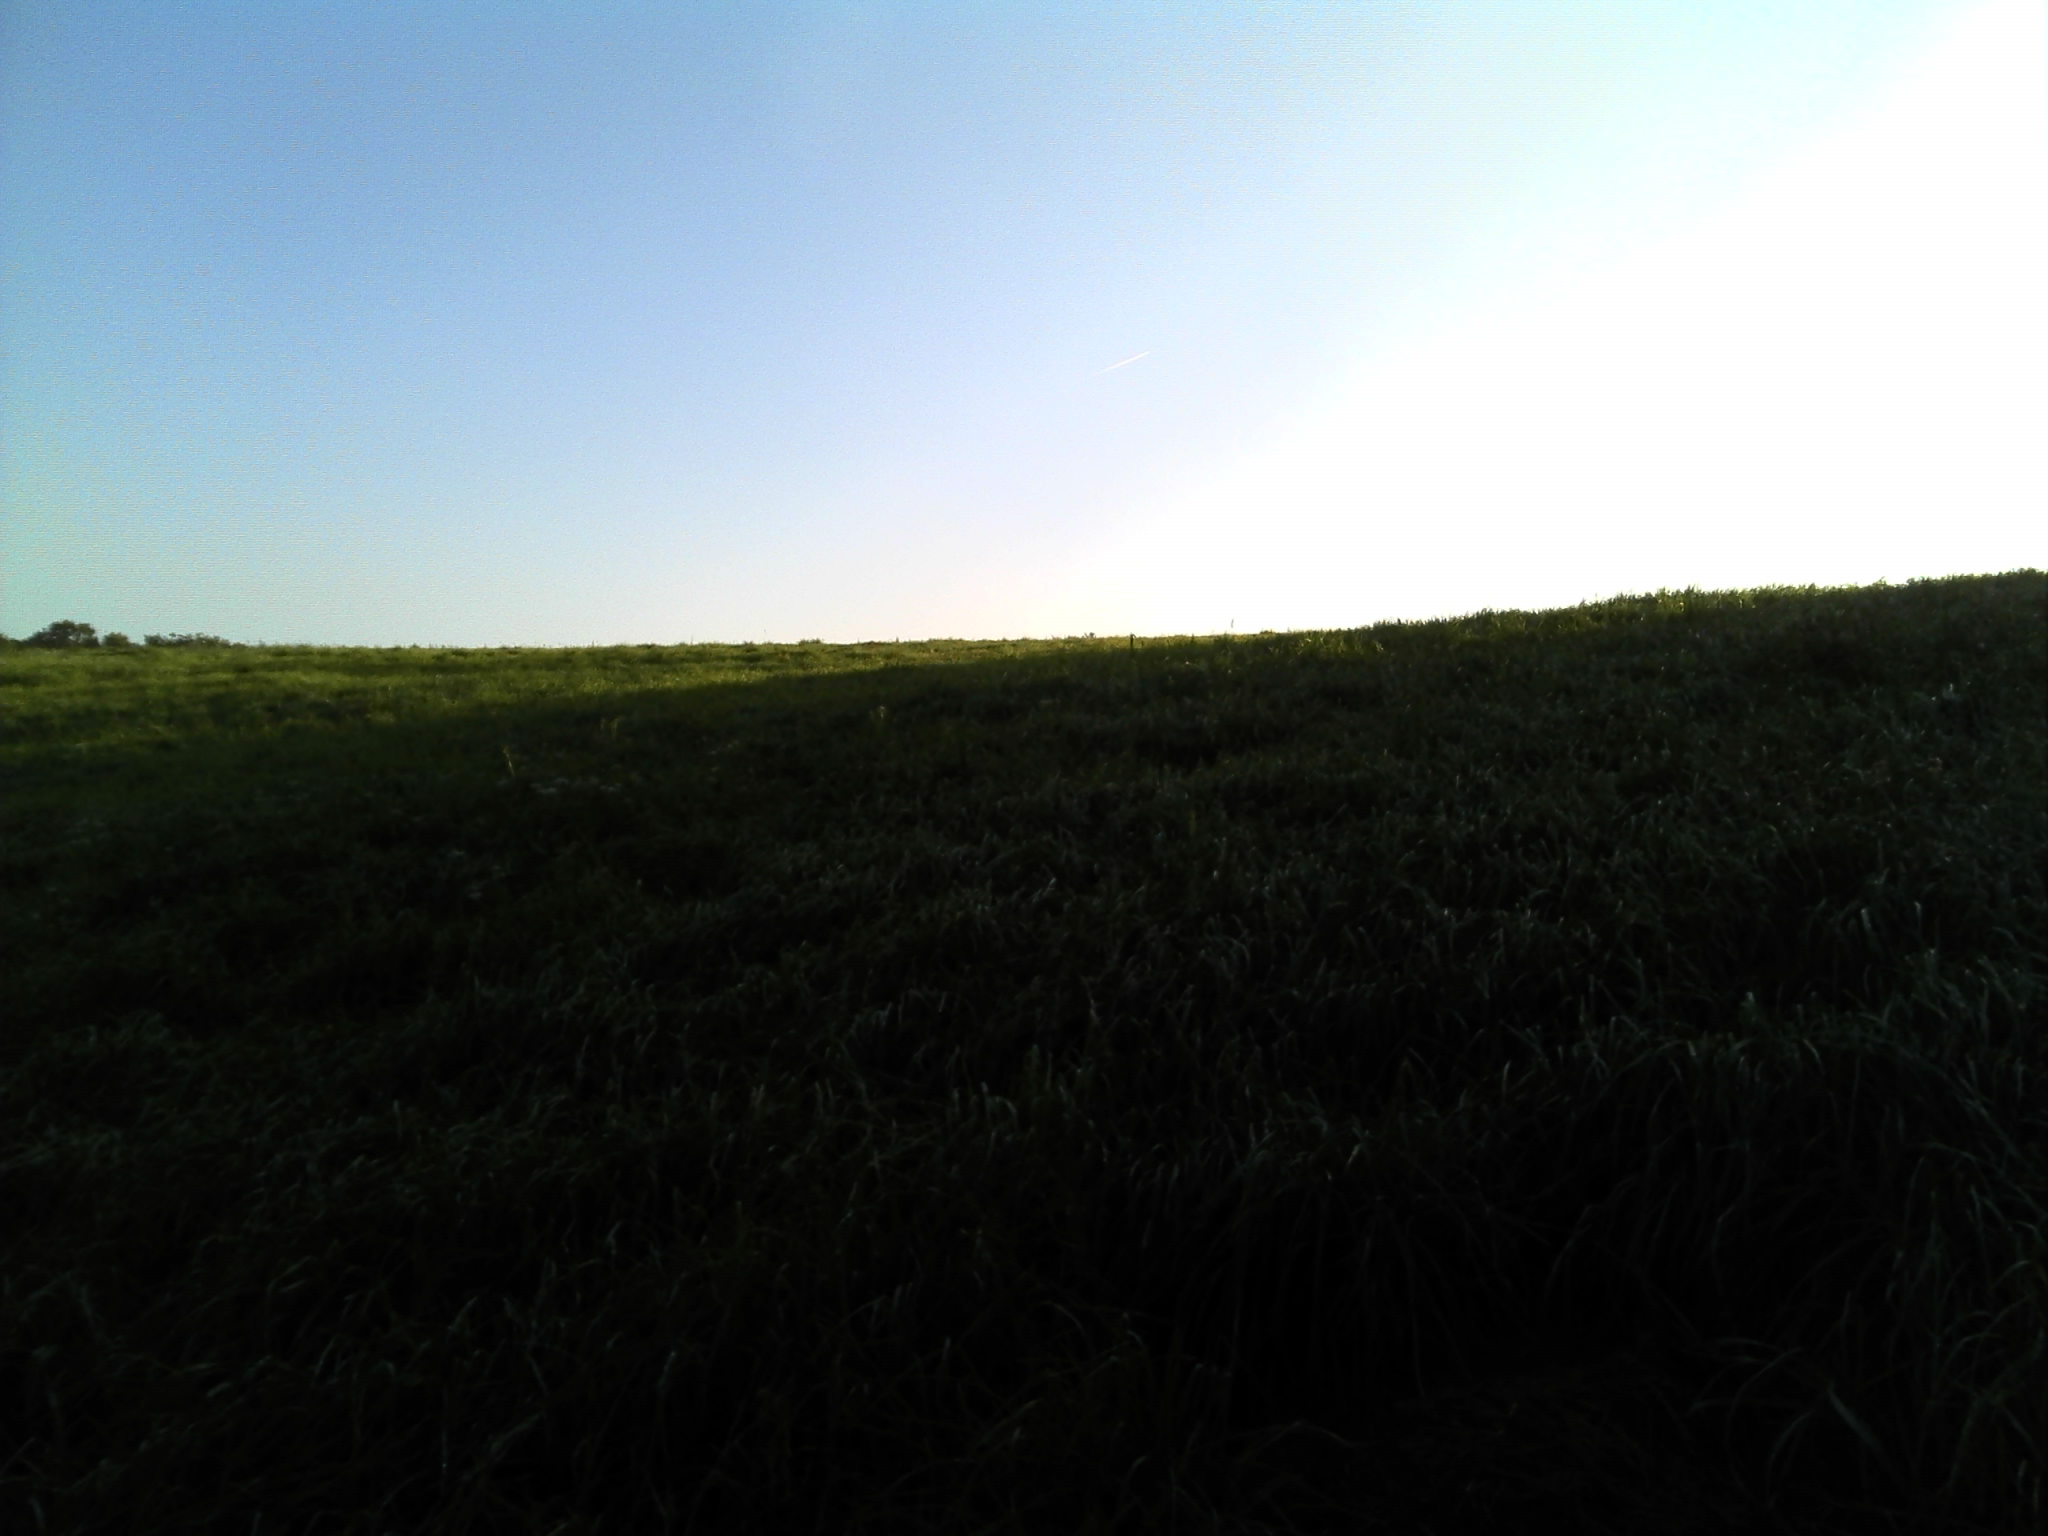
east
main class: Grassland
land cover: Grassland without tree/shrub cover
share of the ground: > 75 %
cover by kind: herbaceous plants 100 %
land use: Agriculture (excluding fallow land and kitchen gardens)
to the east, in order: Grassland without tree/shrub cover; Single bushes/trees; Fences; Grassland without tree/shrub cover
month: October
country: FR
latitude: 47.3462
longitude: -0.9825
